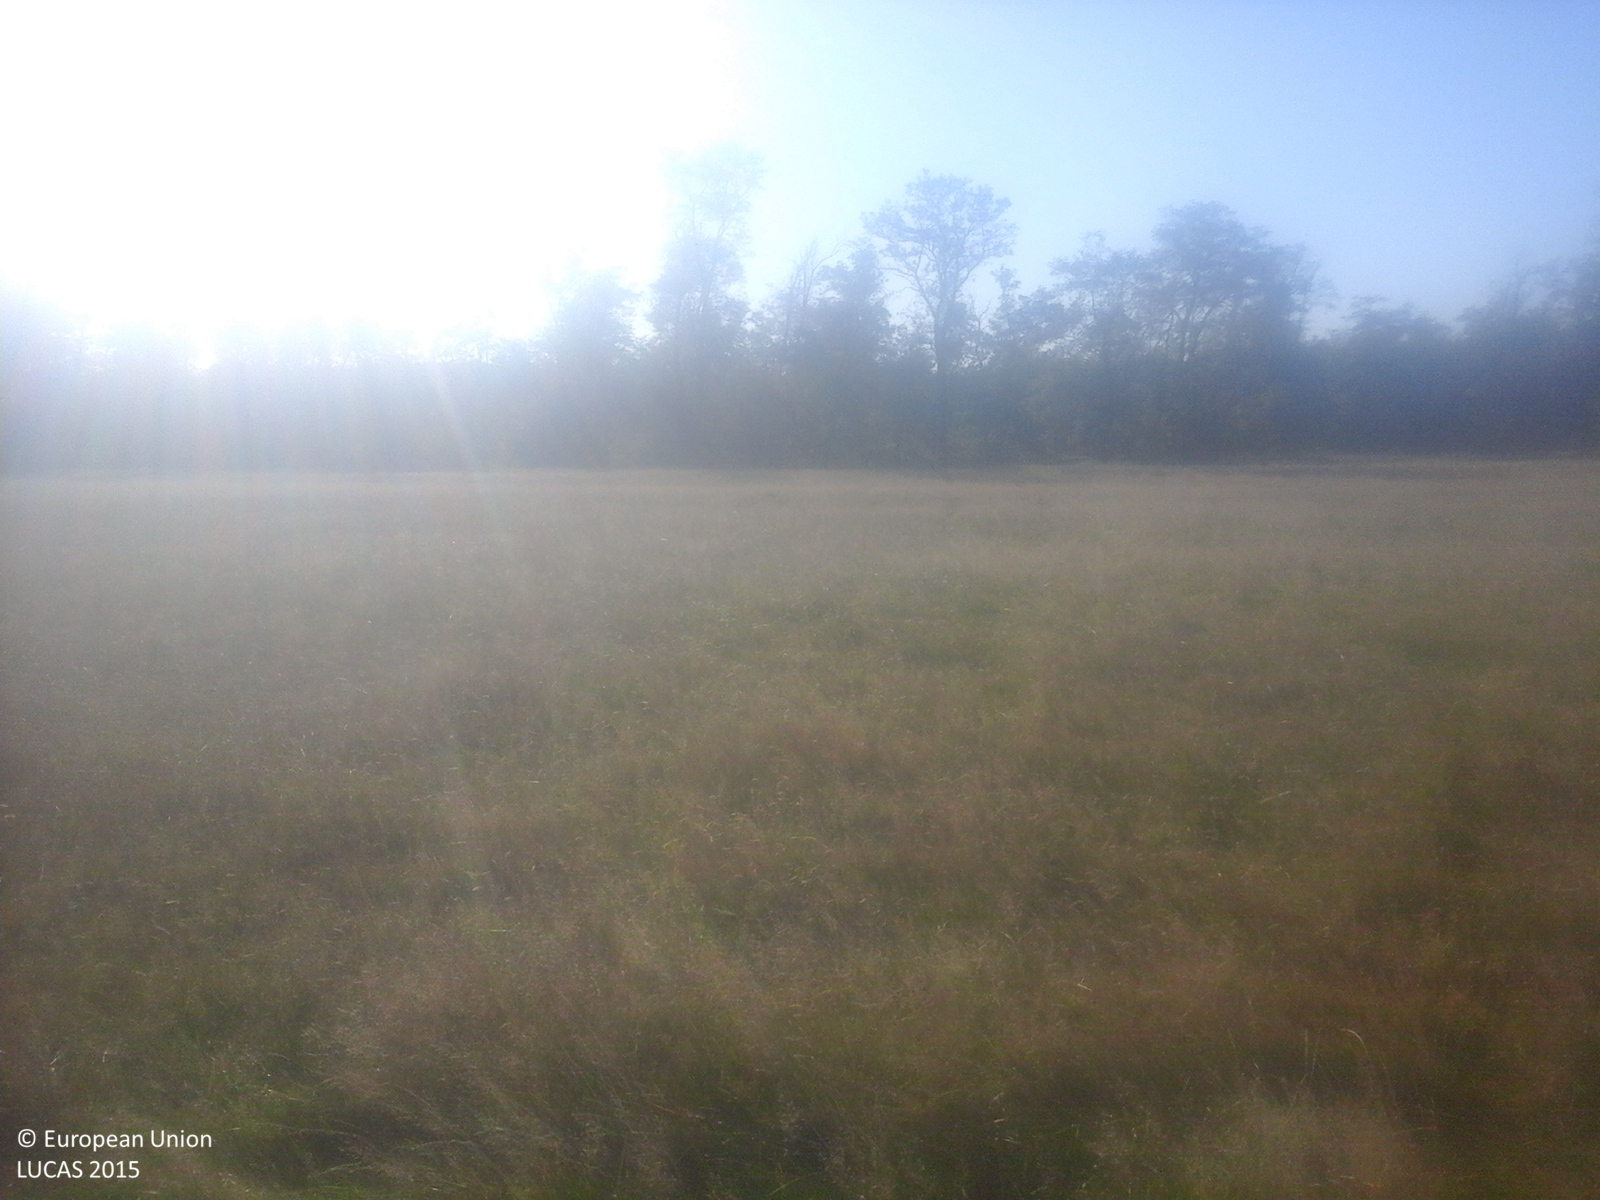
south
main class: Grassland
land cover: Grassland without tree/shrub cover
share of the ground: > 75 %
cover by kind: herbaceous plants 100 %
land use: Agriculture (excluding fallow land and kitchen gardens)
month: October
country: RO
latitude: 45.8774
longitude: 27.0080
